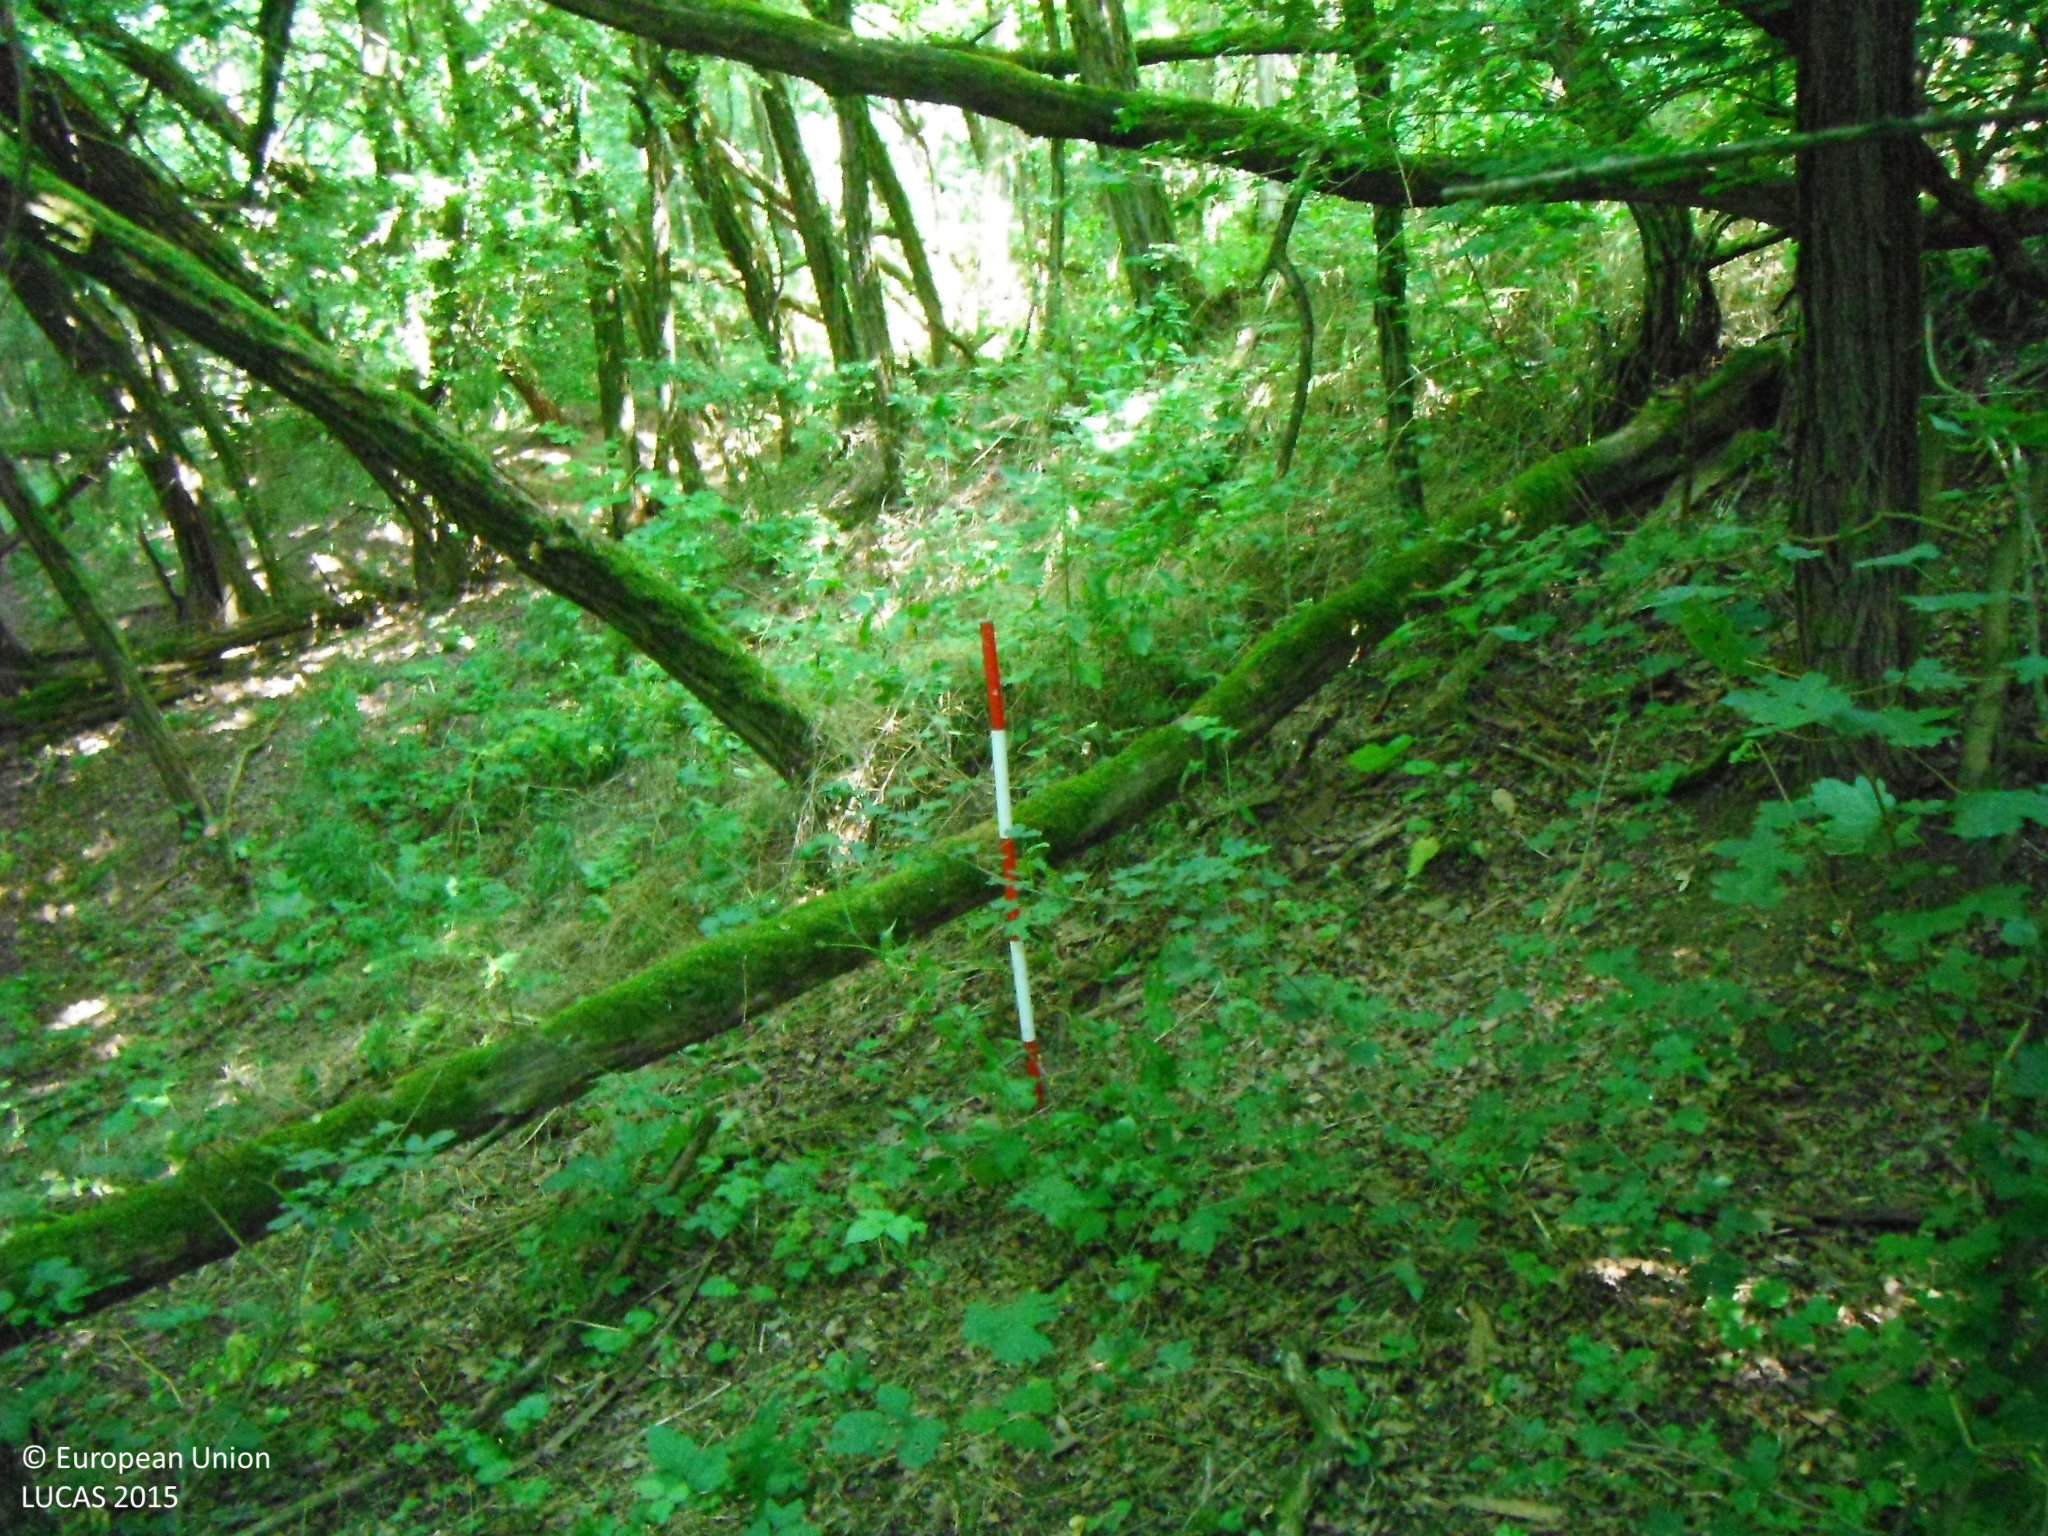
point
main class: Woodland
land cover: Broadleaved woodland
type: exotic forest
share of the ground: > 75 %
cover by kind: broadleaved forest trees 95 %, herbaceous plants 5 %
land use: Forestry
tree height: > 5 m
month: July
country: SK
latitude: 48.1859
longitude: 19.3712
